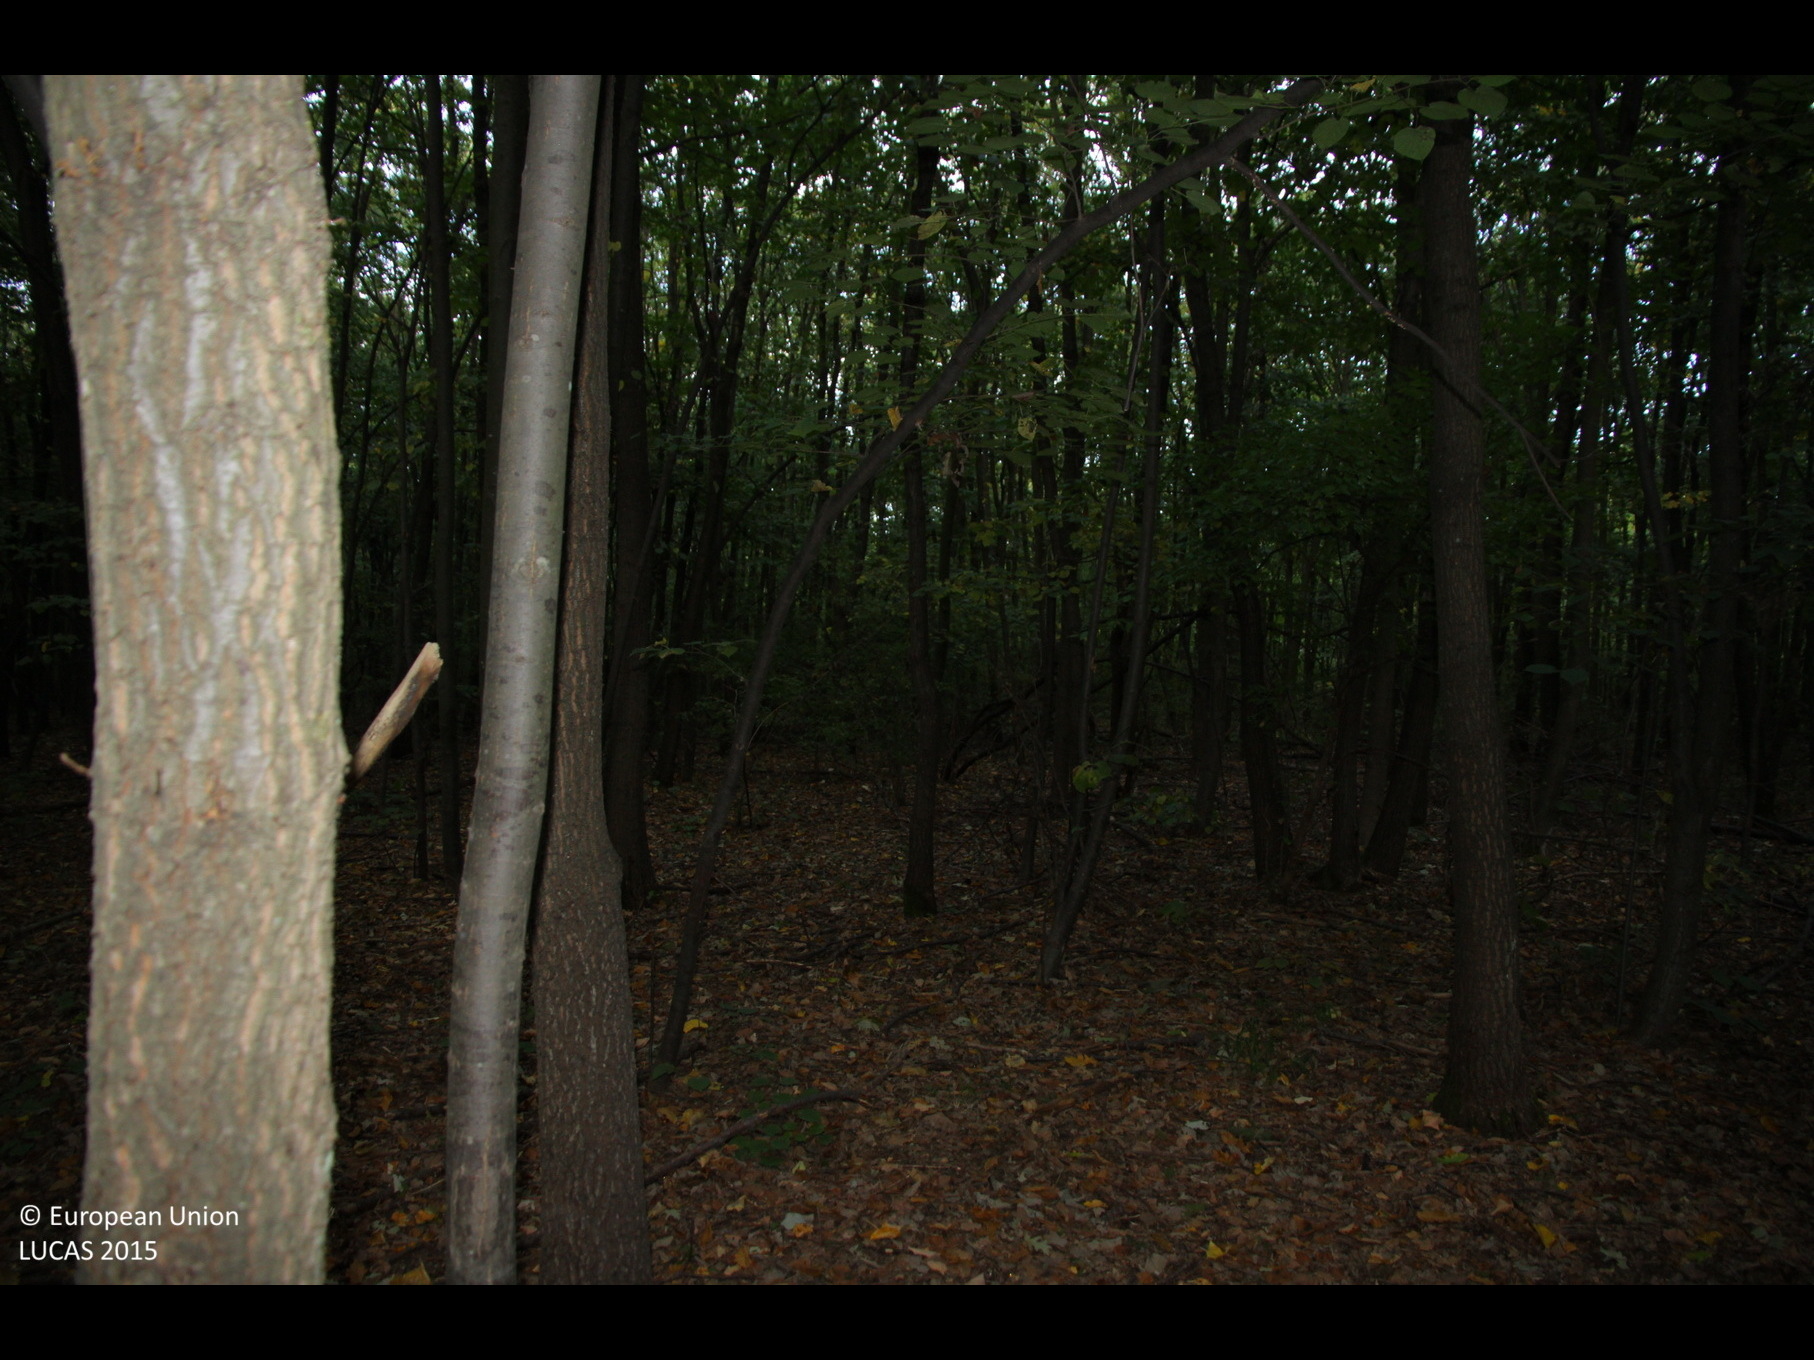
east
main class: Woodland
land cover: Broadleaved woodland
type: beech forest
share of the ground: > 75 %
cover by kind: broadleaved forest trees 100 %
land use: Forestry
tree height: > 5 m
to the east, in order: Broadleaved woodland
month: October
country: BG
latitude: 43.5470
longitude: 27.1911
